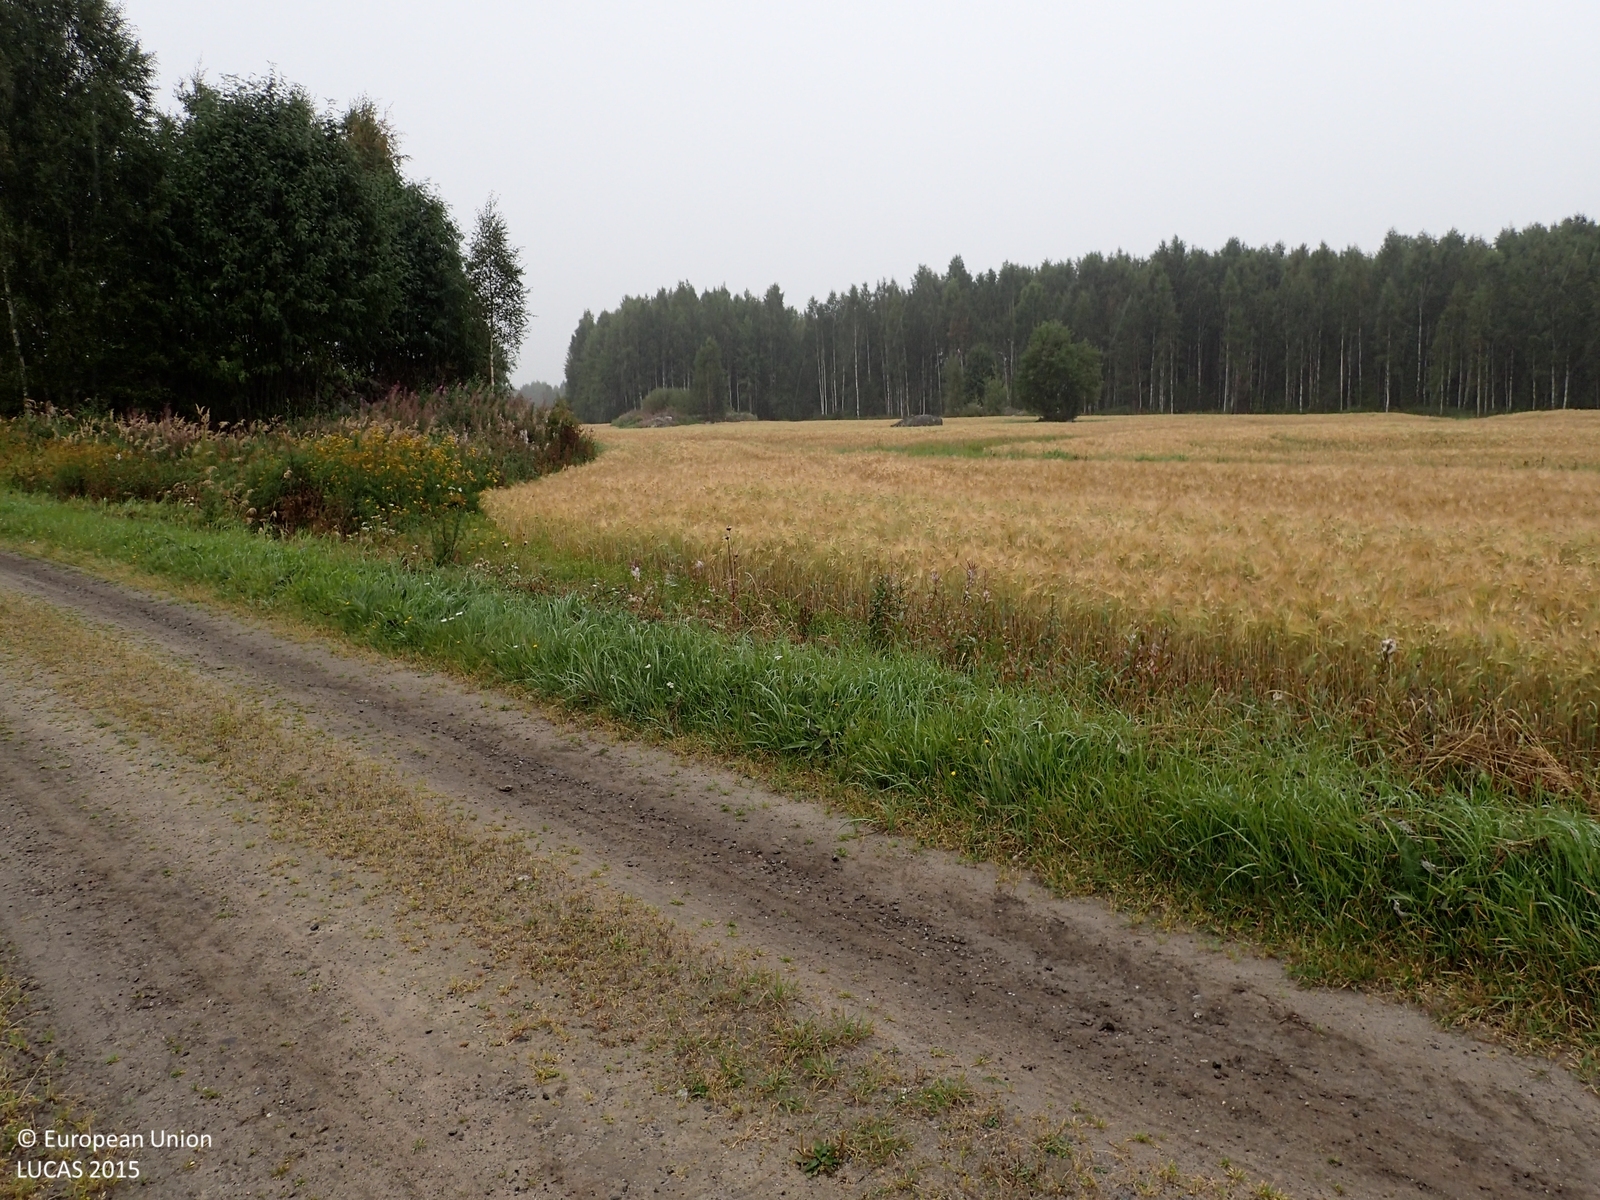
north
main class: Cropland
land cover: Oats
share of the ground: > 75 %
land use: Agriculture (excluding fallow land and kitchen gardens)
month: August
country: FI
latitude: 62.6671
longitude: 22.8065
